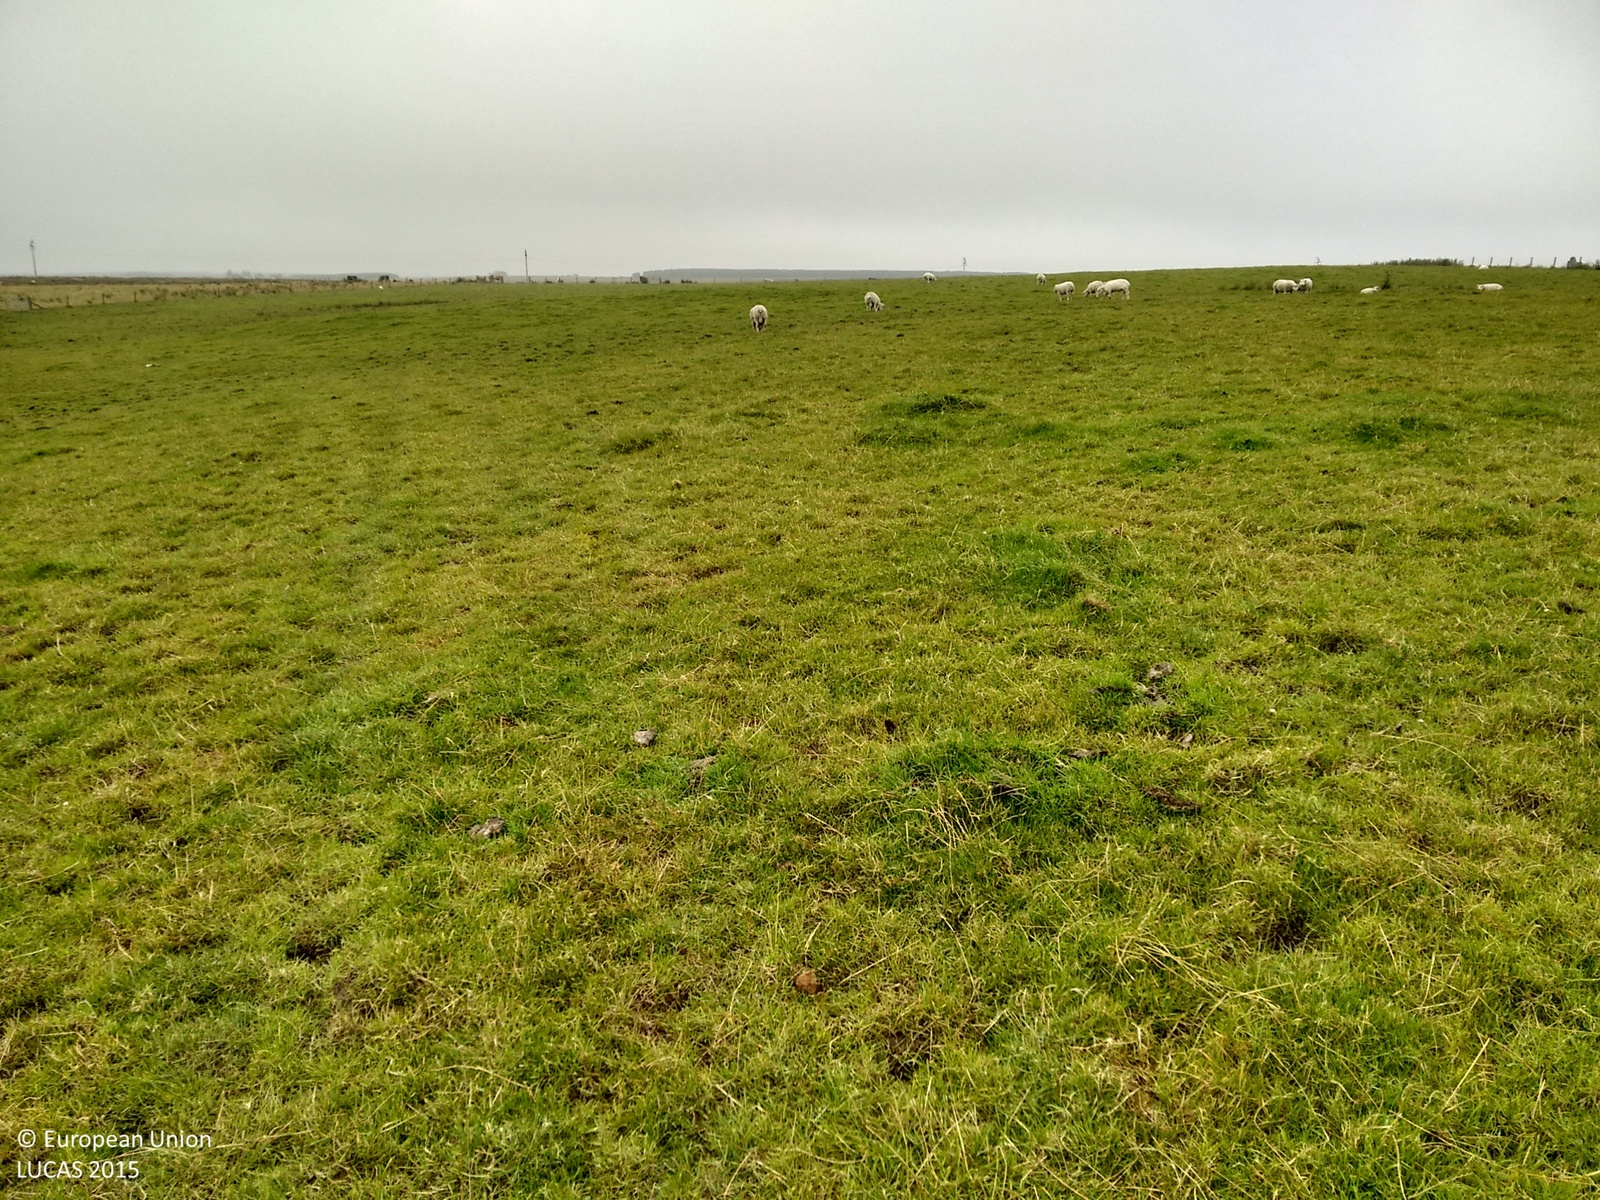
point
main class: Grassland
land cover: Grassland without tree/shrub cover
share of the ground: > 75 %
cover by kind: herbaceous plants 100 %
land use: Agriculture (excluding fallow land and kitchen gardens)
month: August
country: GB
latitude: 58.4526
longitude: -3.2727
